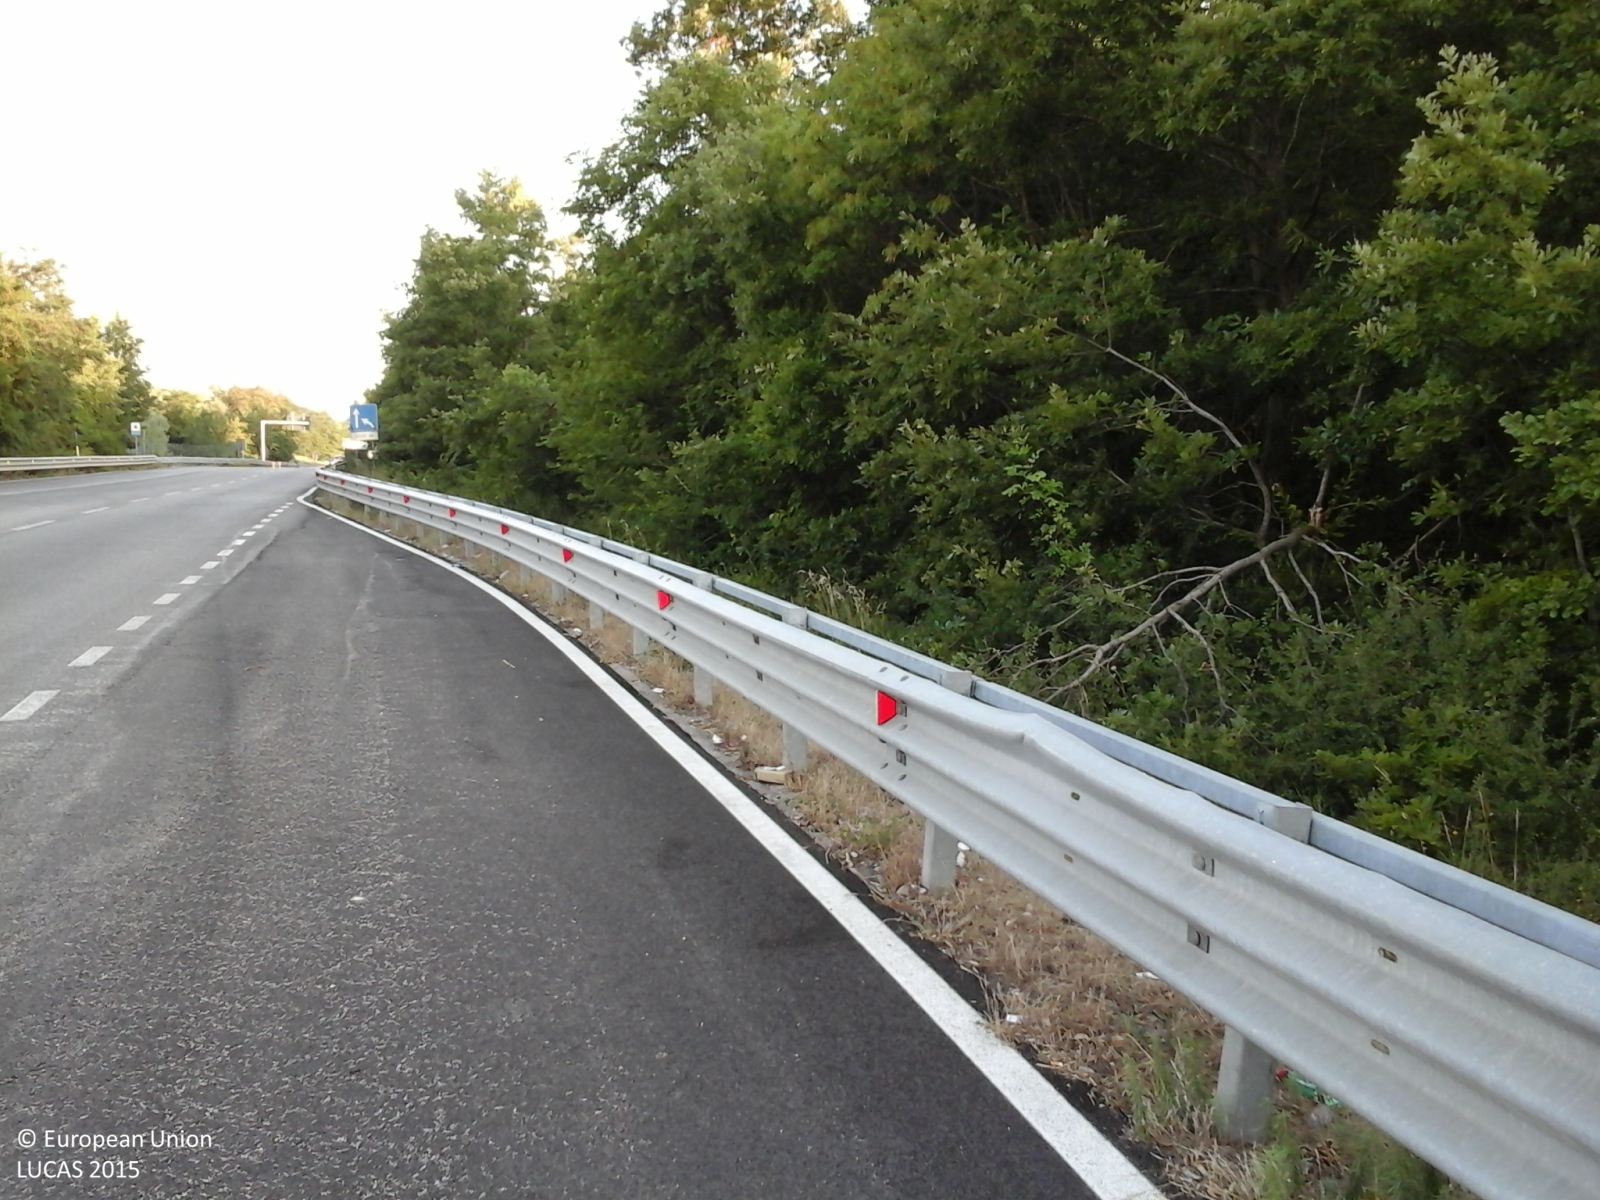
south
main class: Woodland
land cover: Broadleaved woodland
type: thermophilous deciduous forest
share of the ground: > 75 %
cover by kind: broadleaved forest trees 90 %, shrubs 10 %
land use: Semi-natural and natural areas not in use
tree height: > 5 m
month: July
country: IT
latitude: 41.6051
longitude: 14.6755
